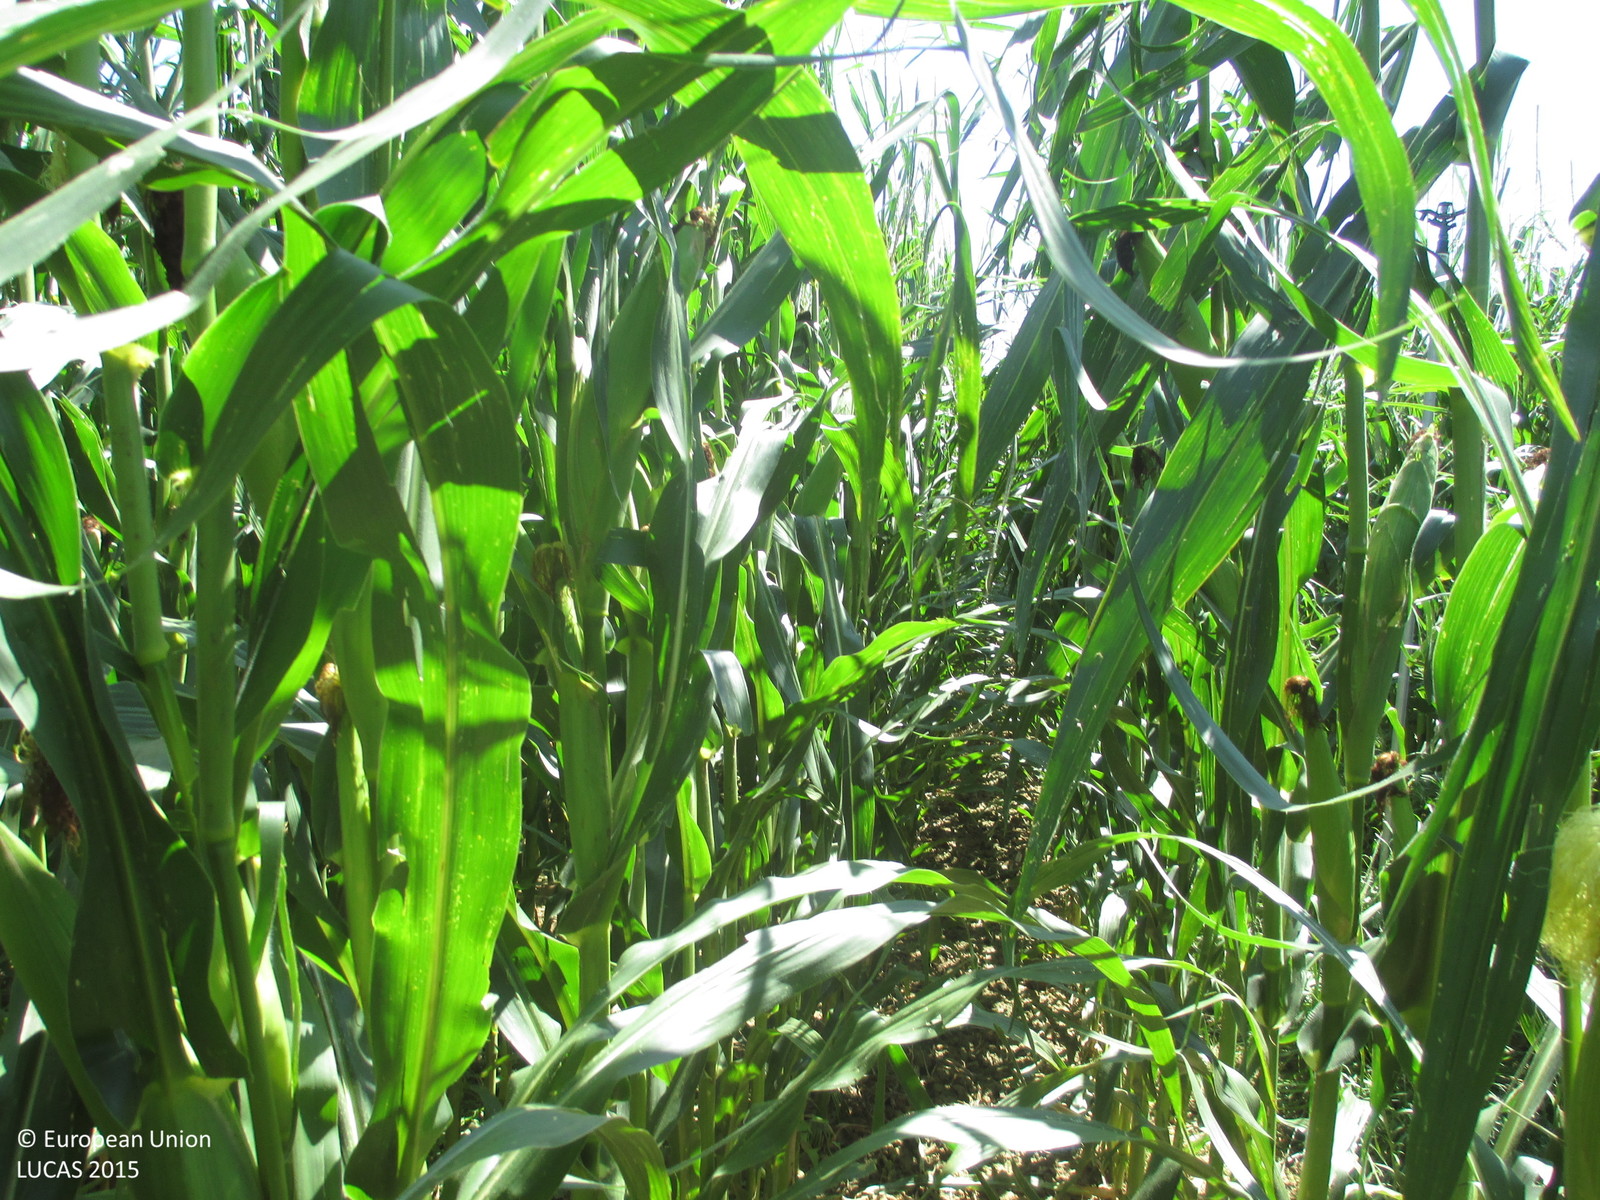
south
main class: Cropland
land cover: Maize
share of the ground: > 75 %
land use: Agriculture (excluding fallow land and kitchen gardens)
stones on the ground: < 10 %
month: July
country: ES
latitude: 41.9320
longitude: 0.1053
